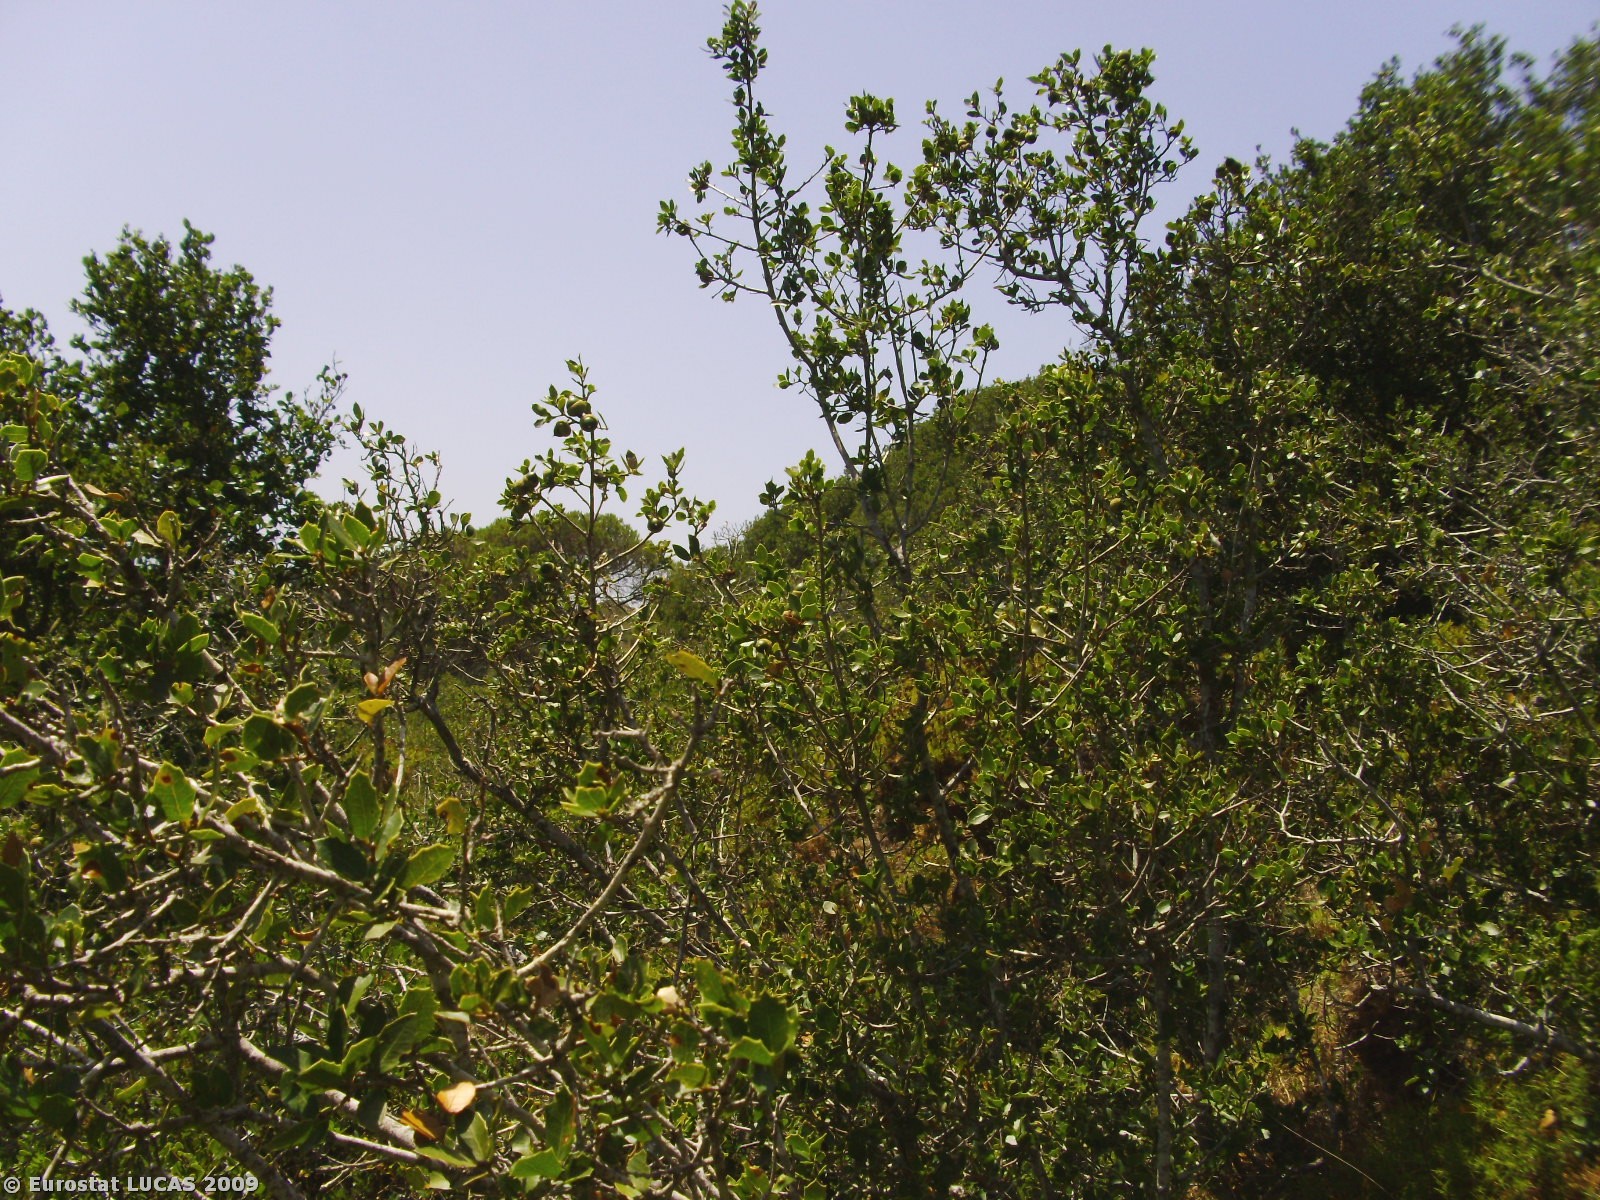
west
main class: Shrubland
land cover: Shrubland with sparse tree cover
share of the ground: > 75 %
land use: Nature reserves
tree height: < 5 m
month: July
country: PT
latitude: 38.4537
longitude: -9.1492
